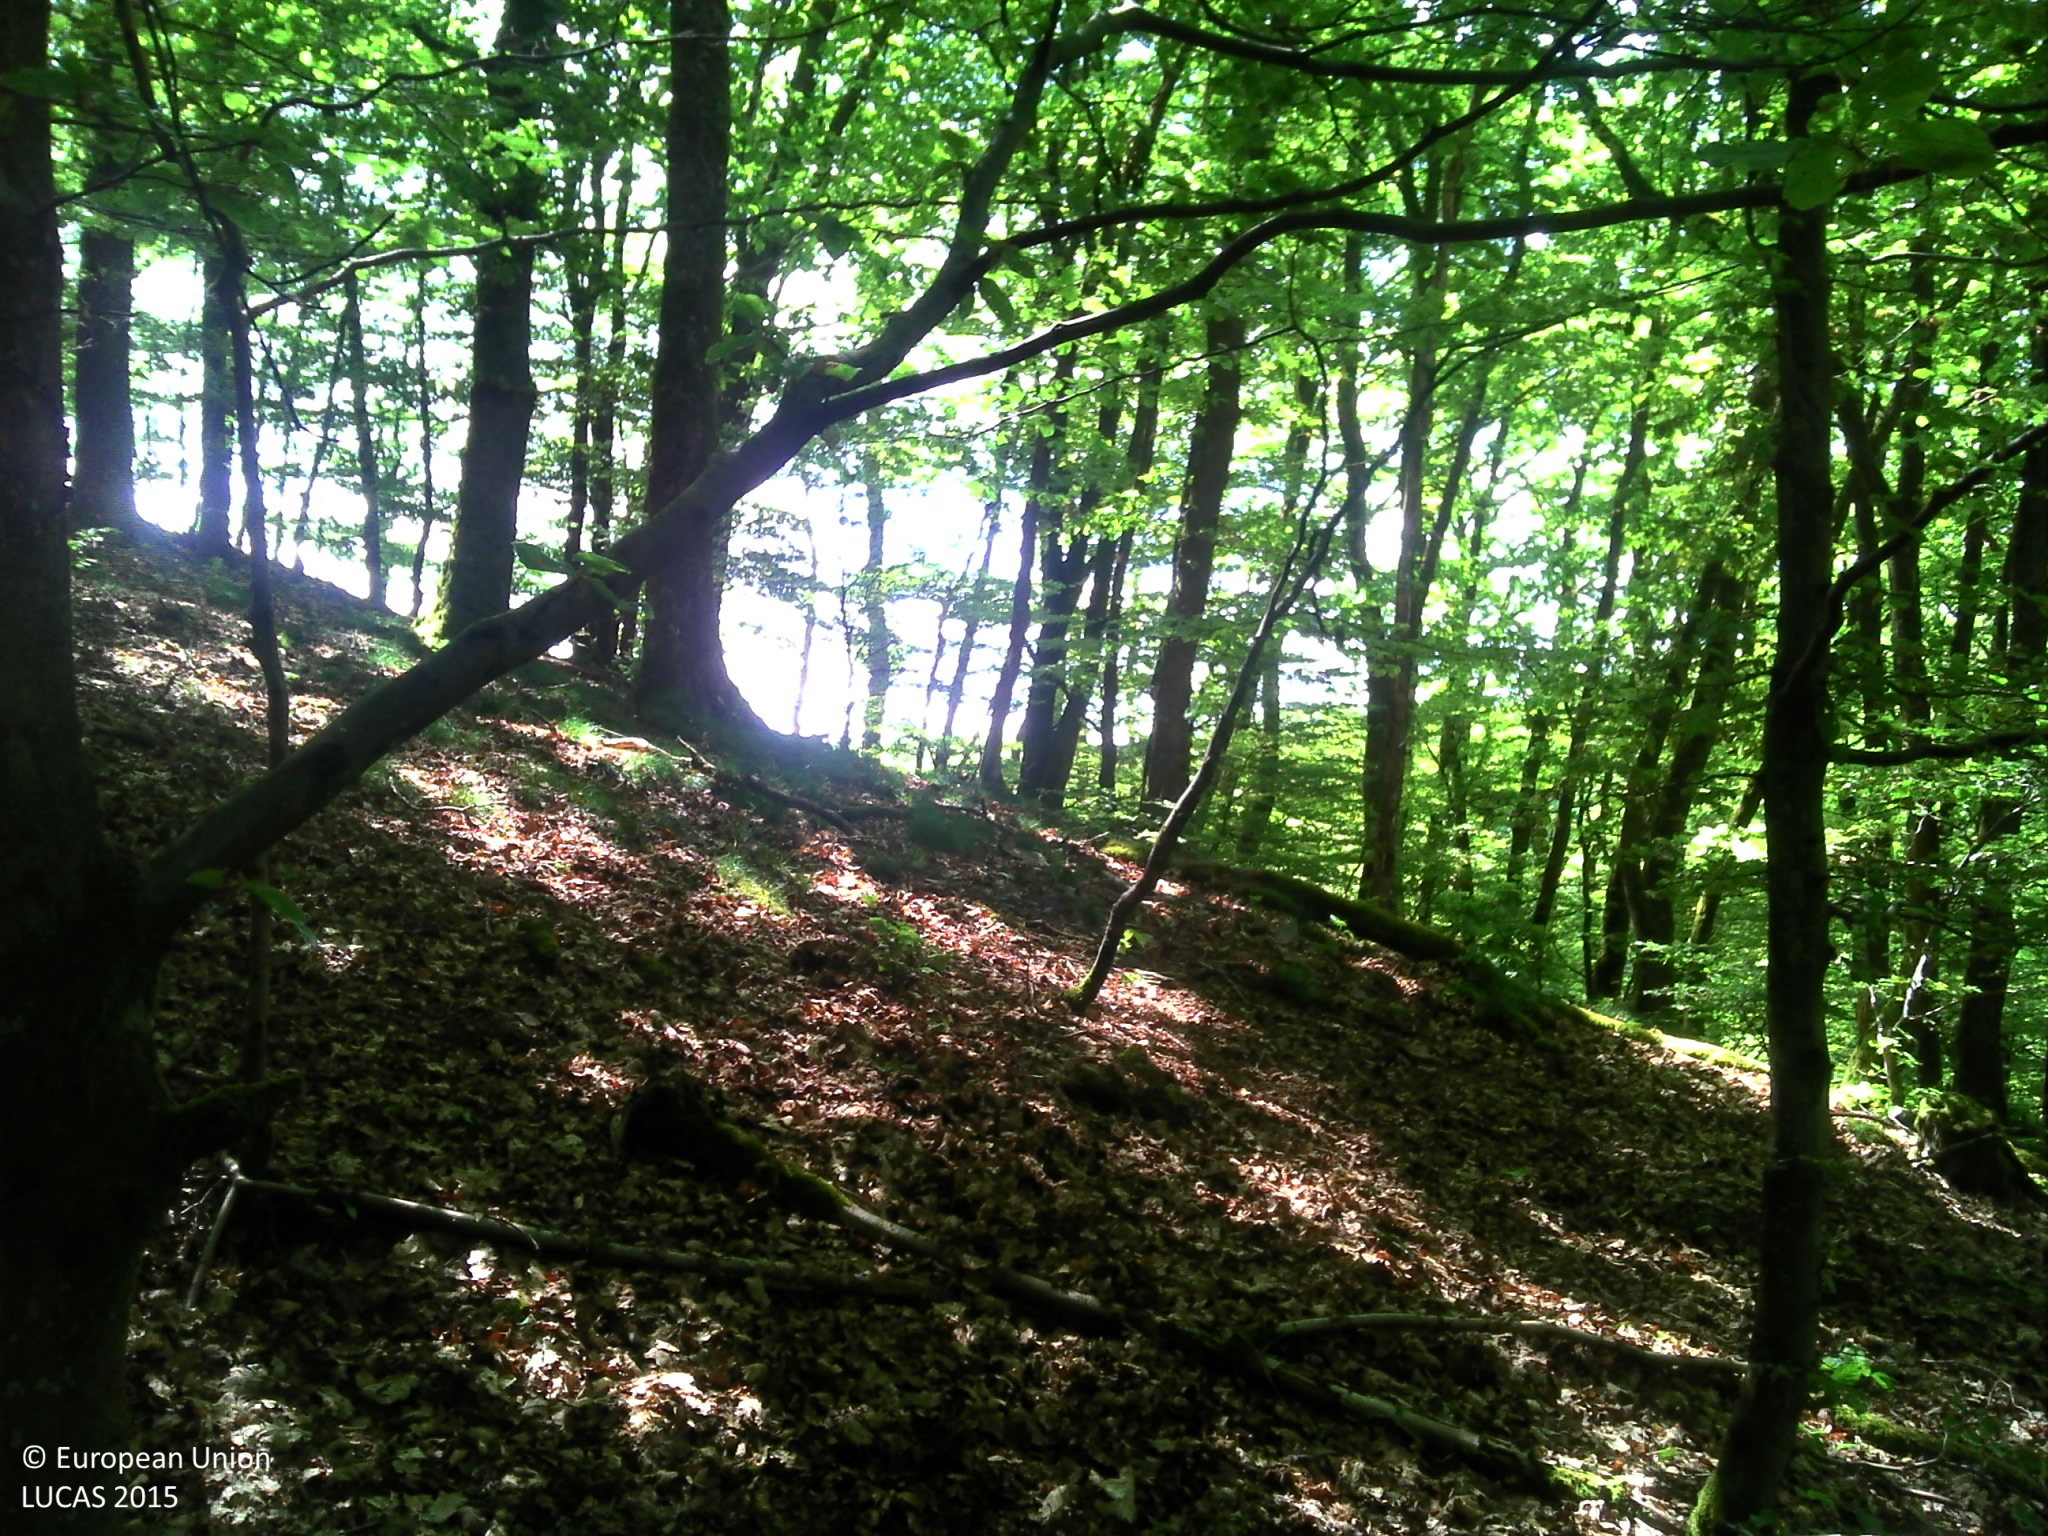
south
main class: Woodland
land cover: Broadleaved woodland
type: acidophilous oak and oak-birch forest
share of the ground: > 75 %
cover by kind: broadleaved forest trees 100 %
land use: Forestry
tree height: > 5 m
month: May
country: LU
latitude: 49.8583
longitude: 5.8955
